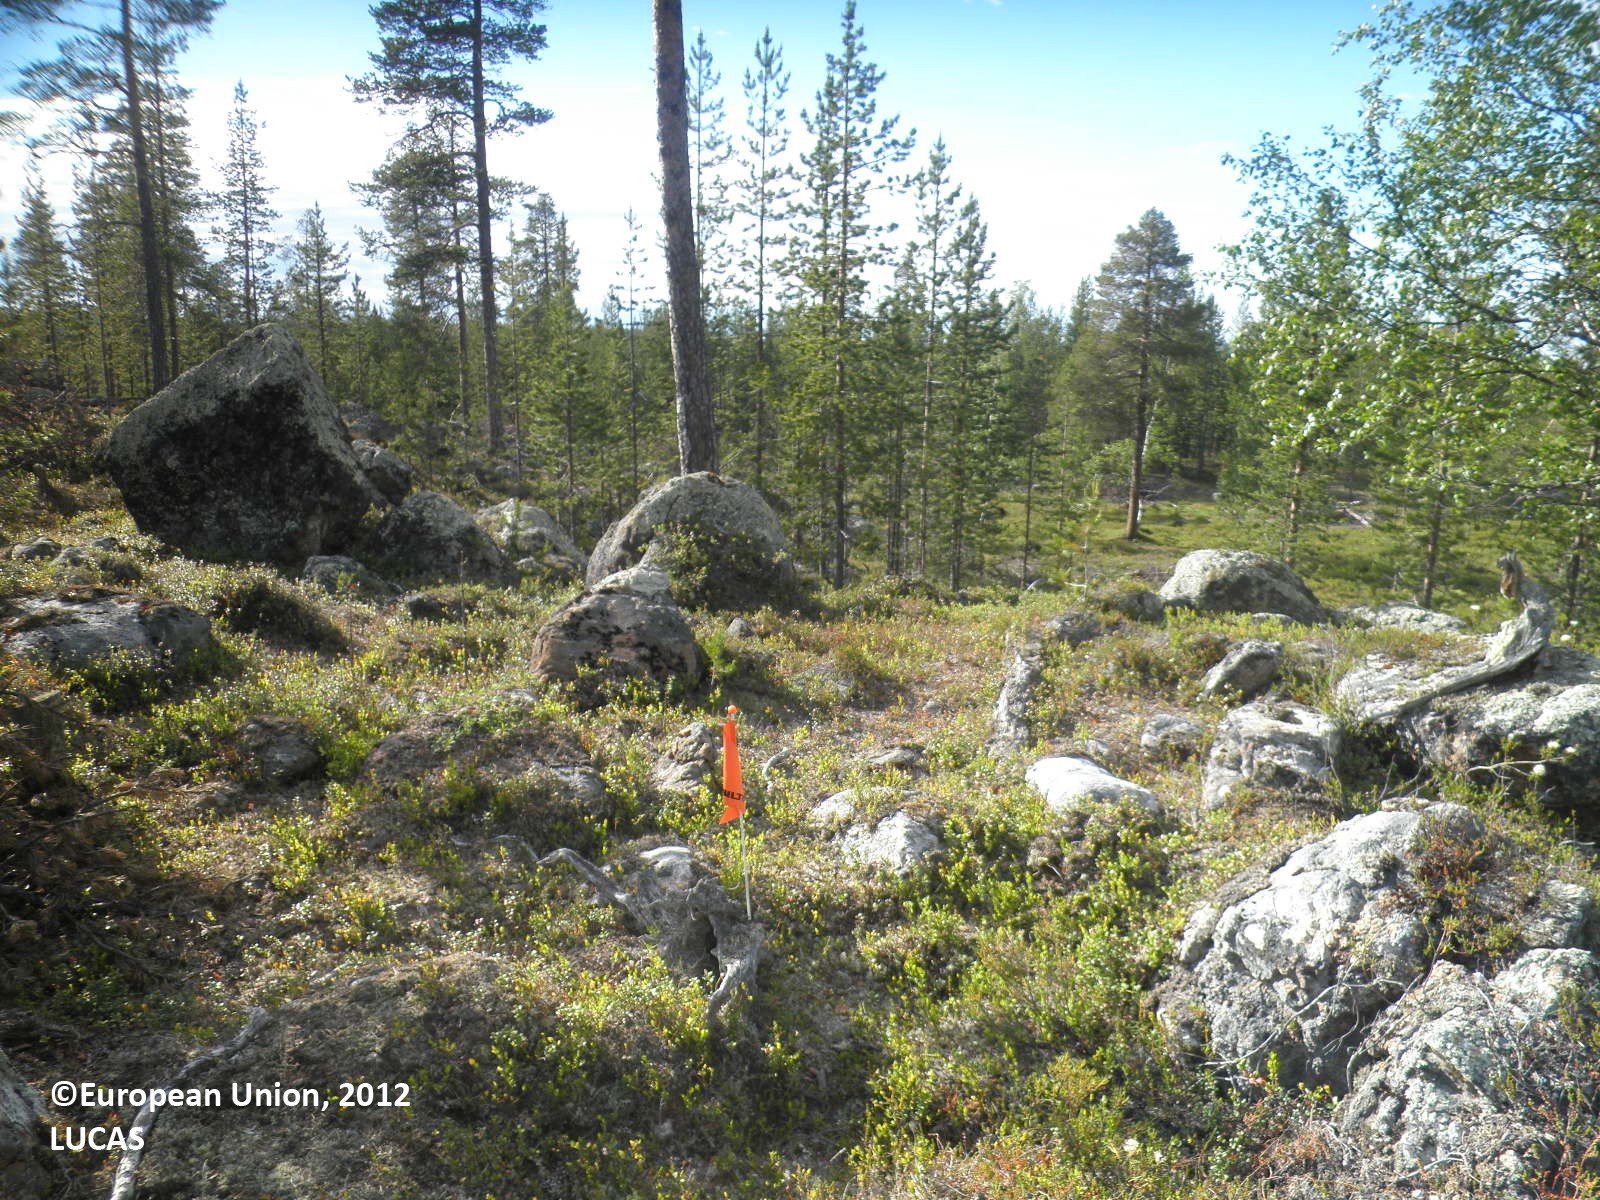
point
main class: Woodland
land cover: Pine dominated coniferous woodland
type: boreal forest
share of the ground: 10 - 25 %
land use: Forestry
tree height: > 5 m
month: July
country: FI
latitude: 68.8843
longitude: 27.1003
